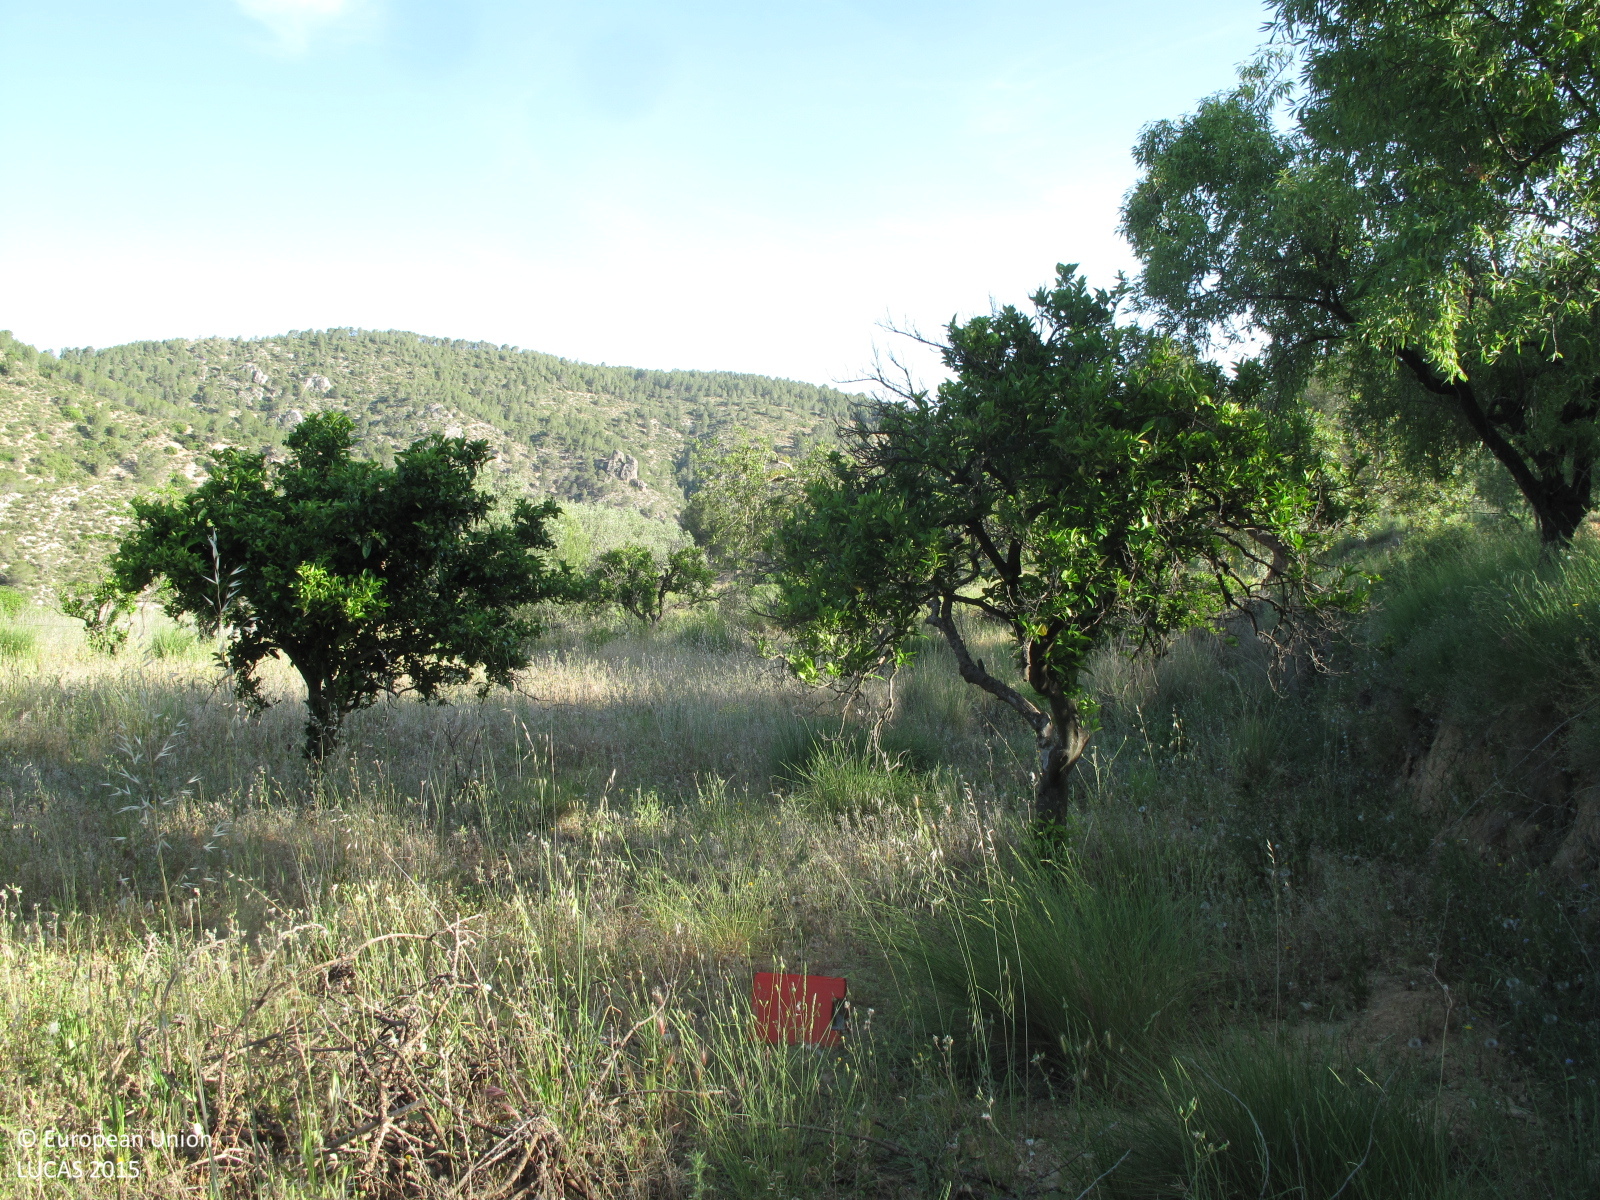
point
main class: Cropland
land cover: Oranges
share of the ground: 10 - 25 %
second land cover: Spontaneously vegetated surfaces
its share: > 75 %
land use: Agriculture (excluding fallow land and kitchen gardens)
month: May
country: ES
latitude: 39.1080
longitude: -0.7615
